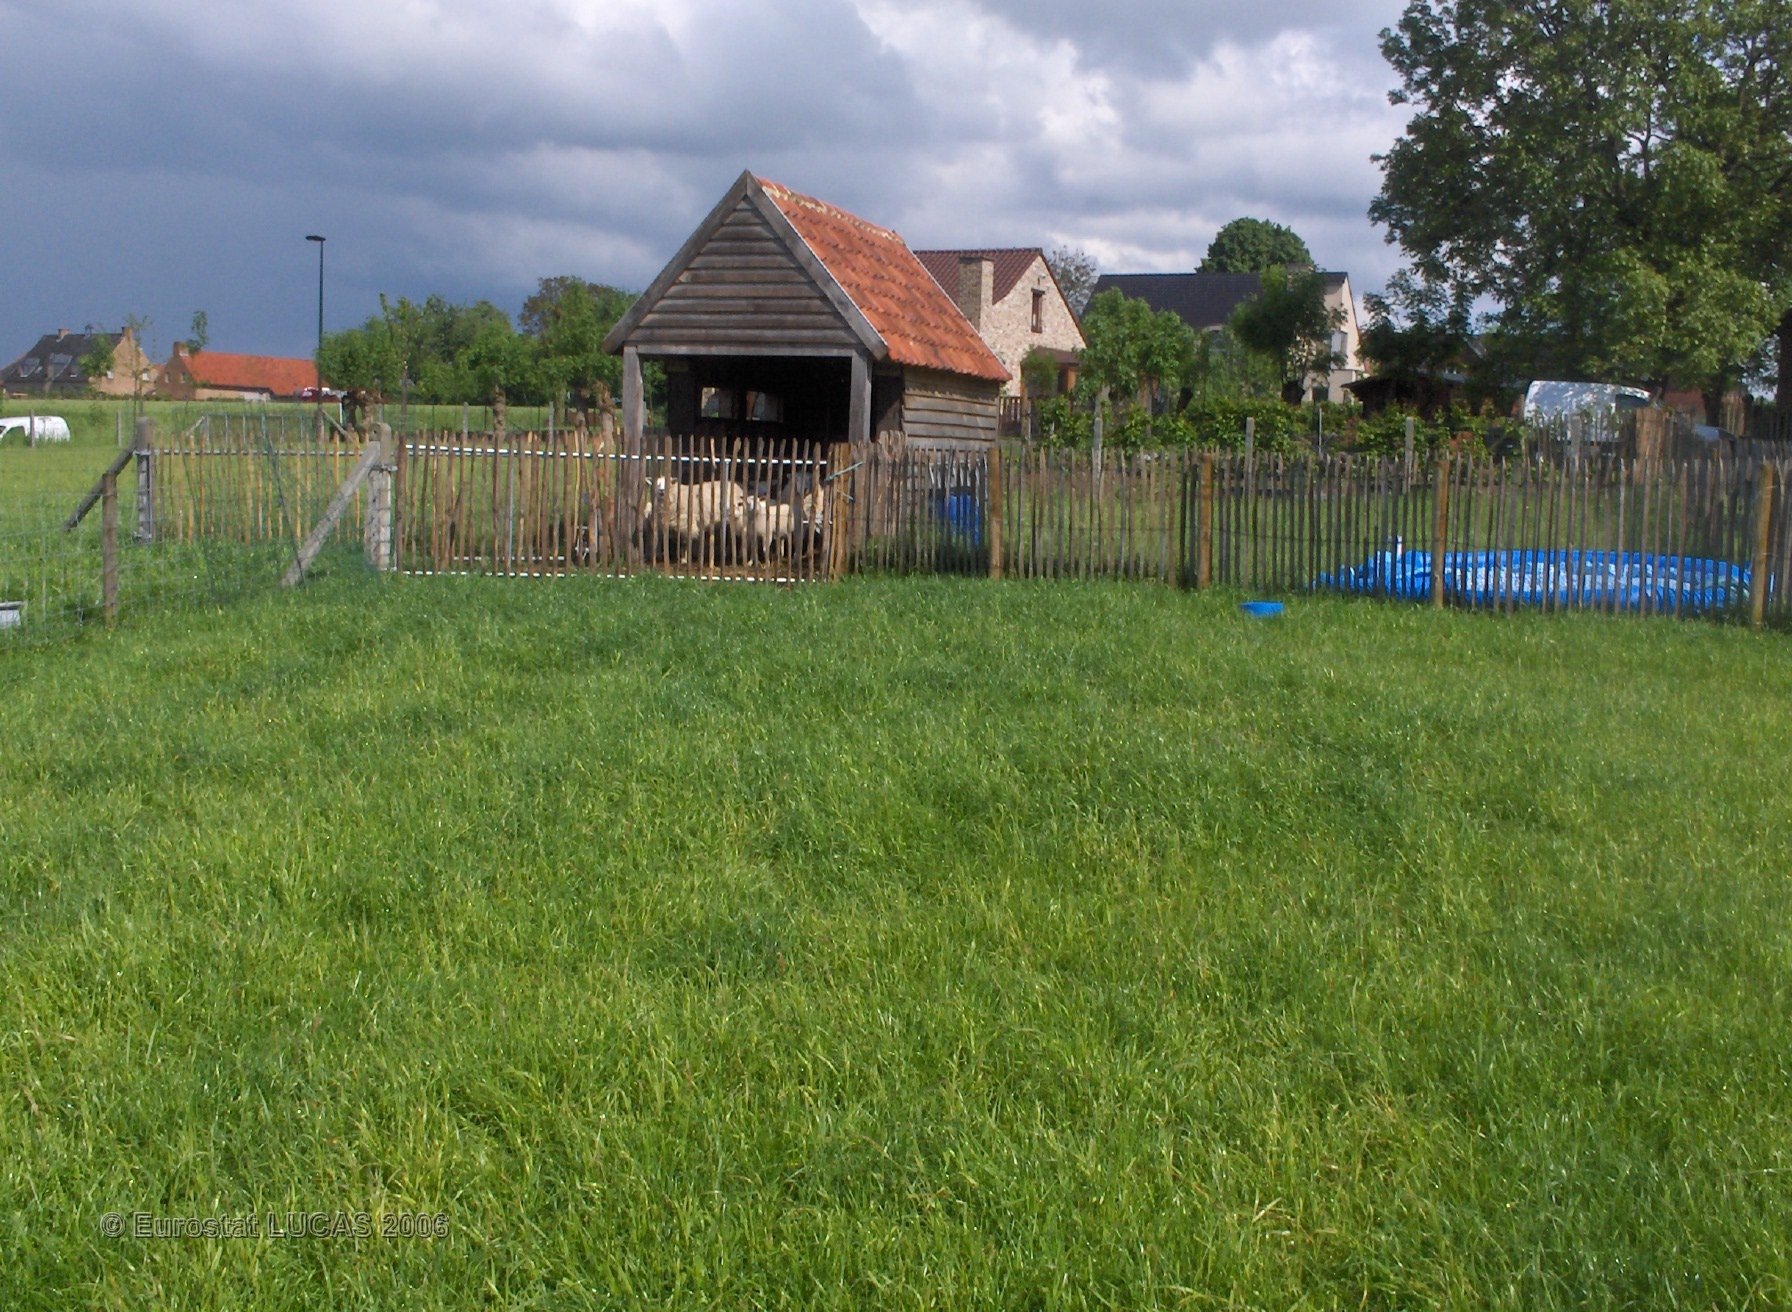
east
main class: Grassland
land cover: Grassland with sparse tree/shrub cover
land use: Agriculture (excluding fallow land and kitchen gardens)
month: May
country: BE
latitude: 50.8398
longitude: 3.7021
